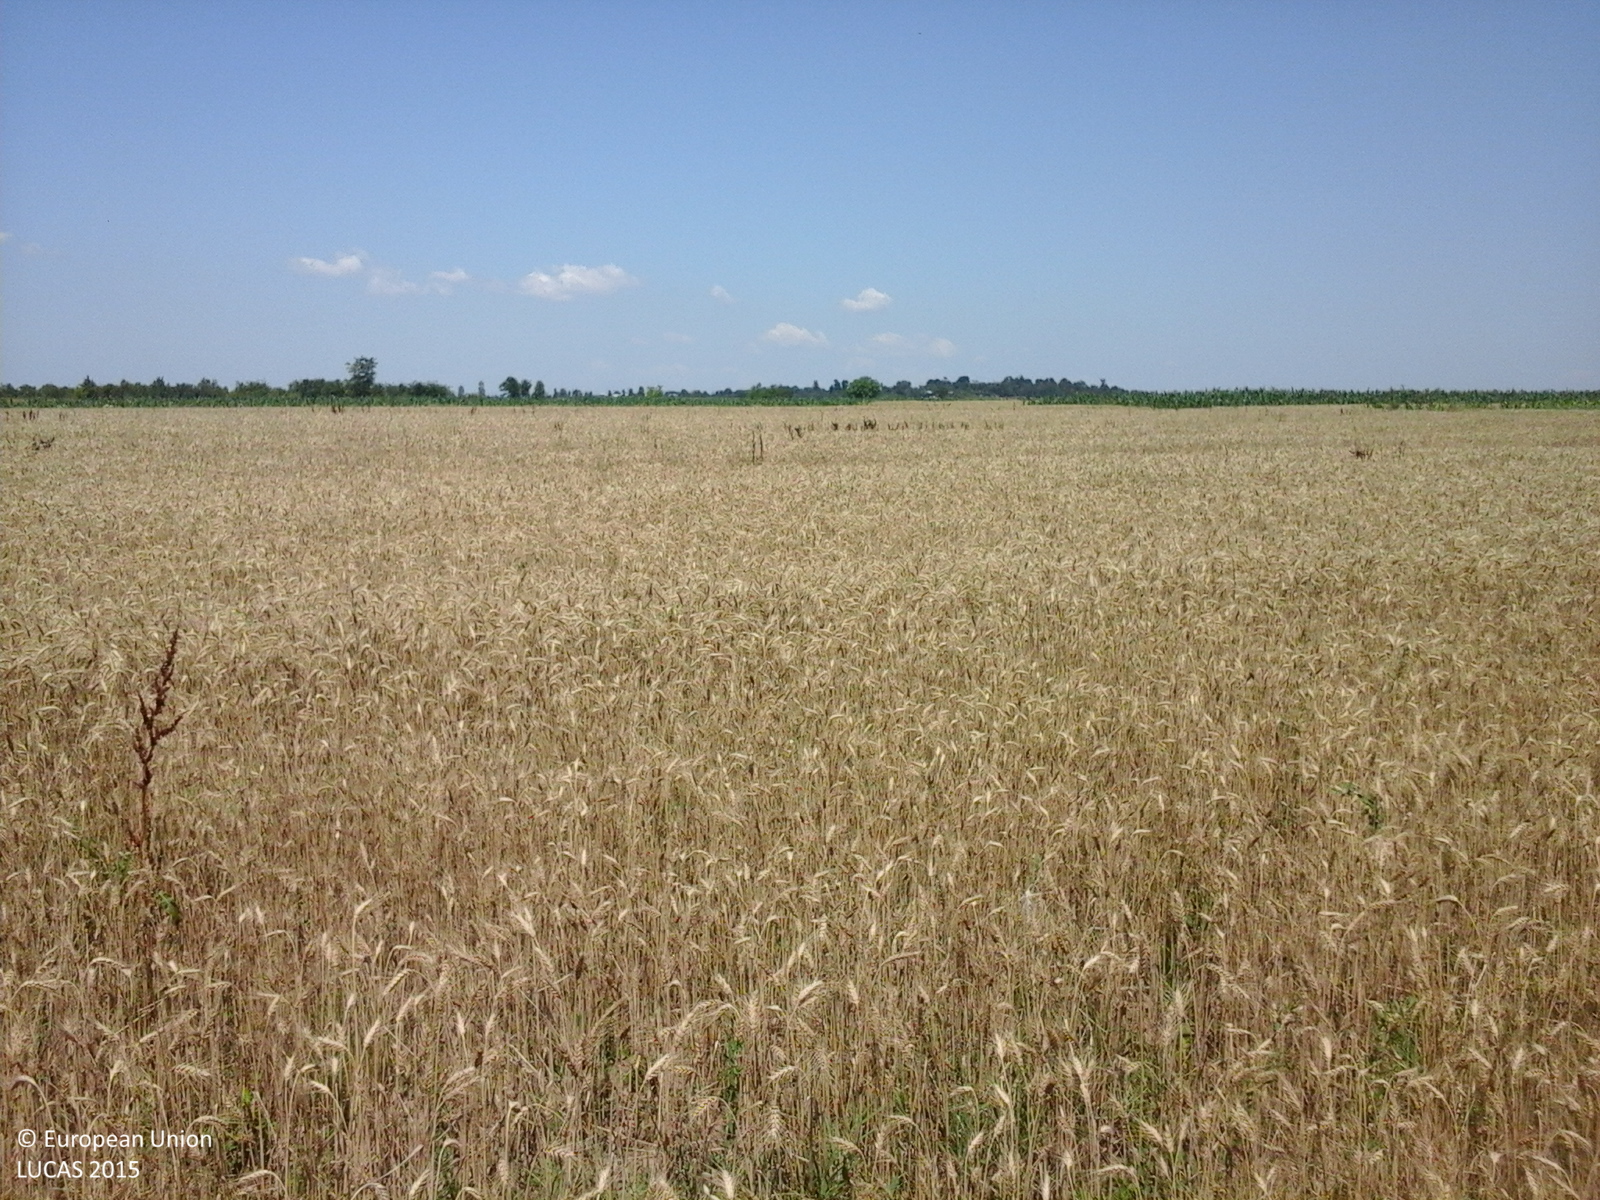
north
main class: Cropland
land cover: Common wheat
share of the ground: > 75 %
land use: Agriculture (excluding fallow land and kitchen gardens)
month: July
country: RO
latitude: 44.4765
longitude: 24.6445
